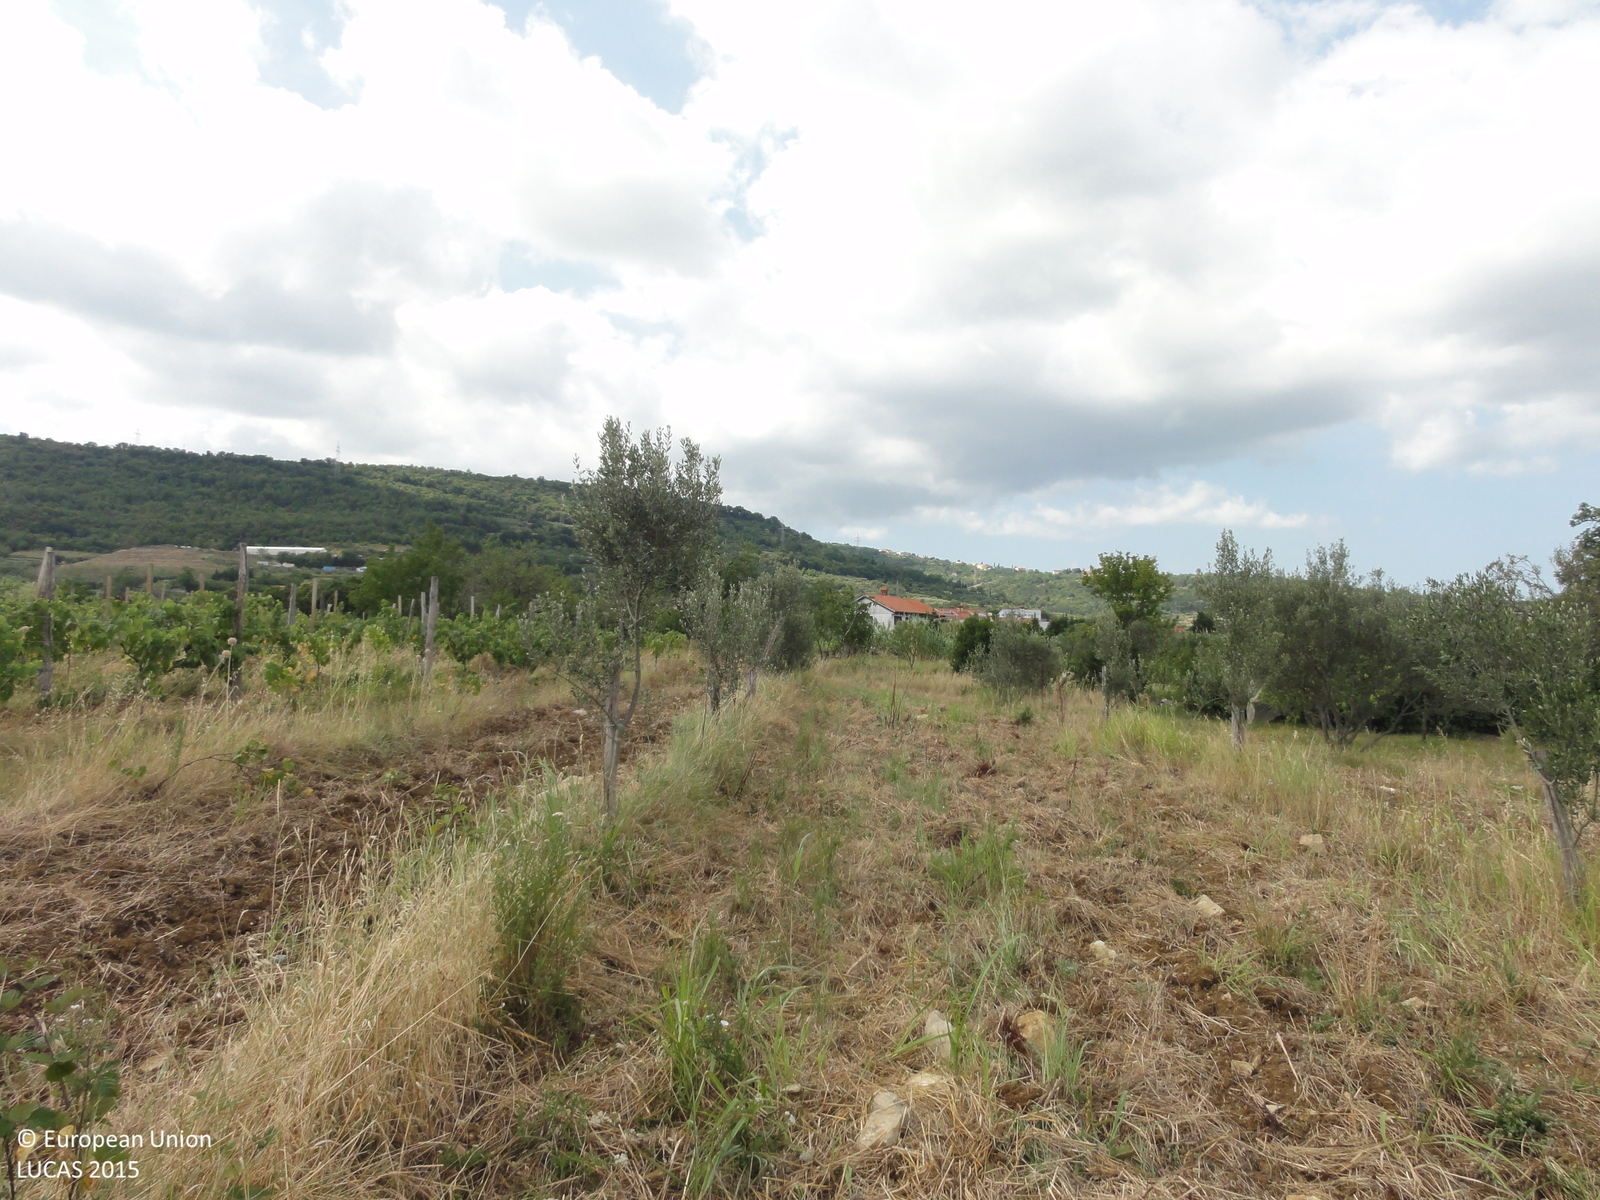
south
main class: Cropland
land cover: Olive groves
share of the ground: 10 - 25 %
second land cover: Grassland without tree/shrub cover
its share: > 75 %
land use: Agriculture (excluding fallow land and kitchen gardens)
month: July
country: SI
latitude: 45.5308
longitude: 13.6703
